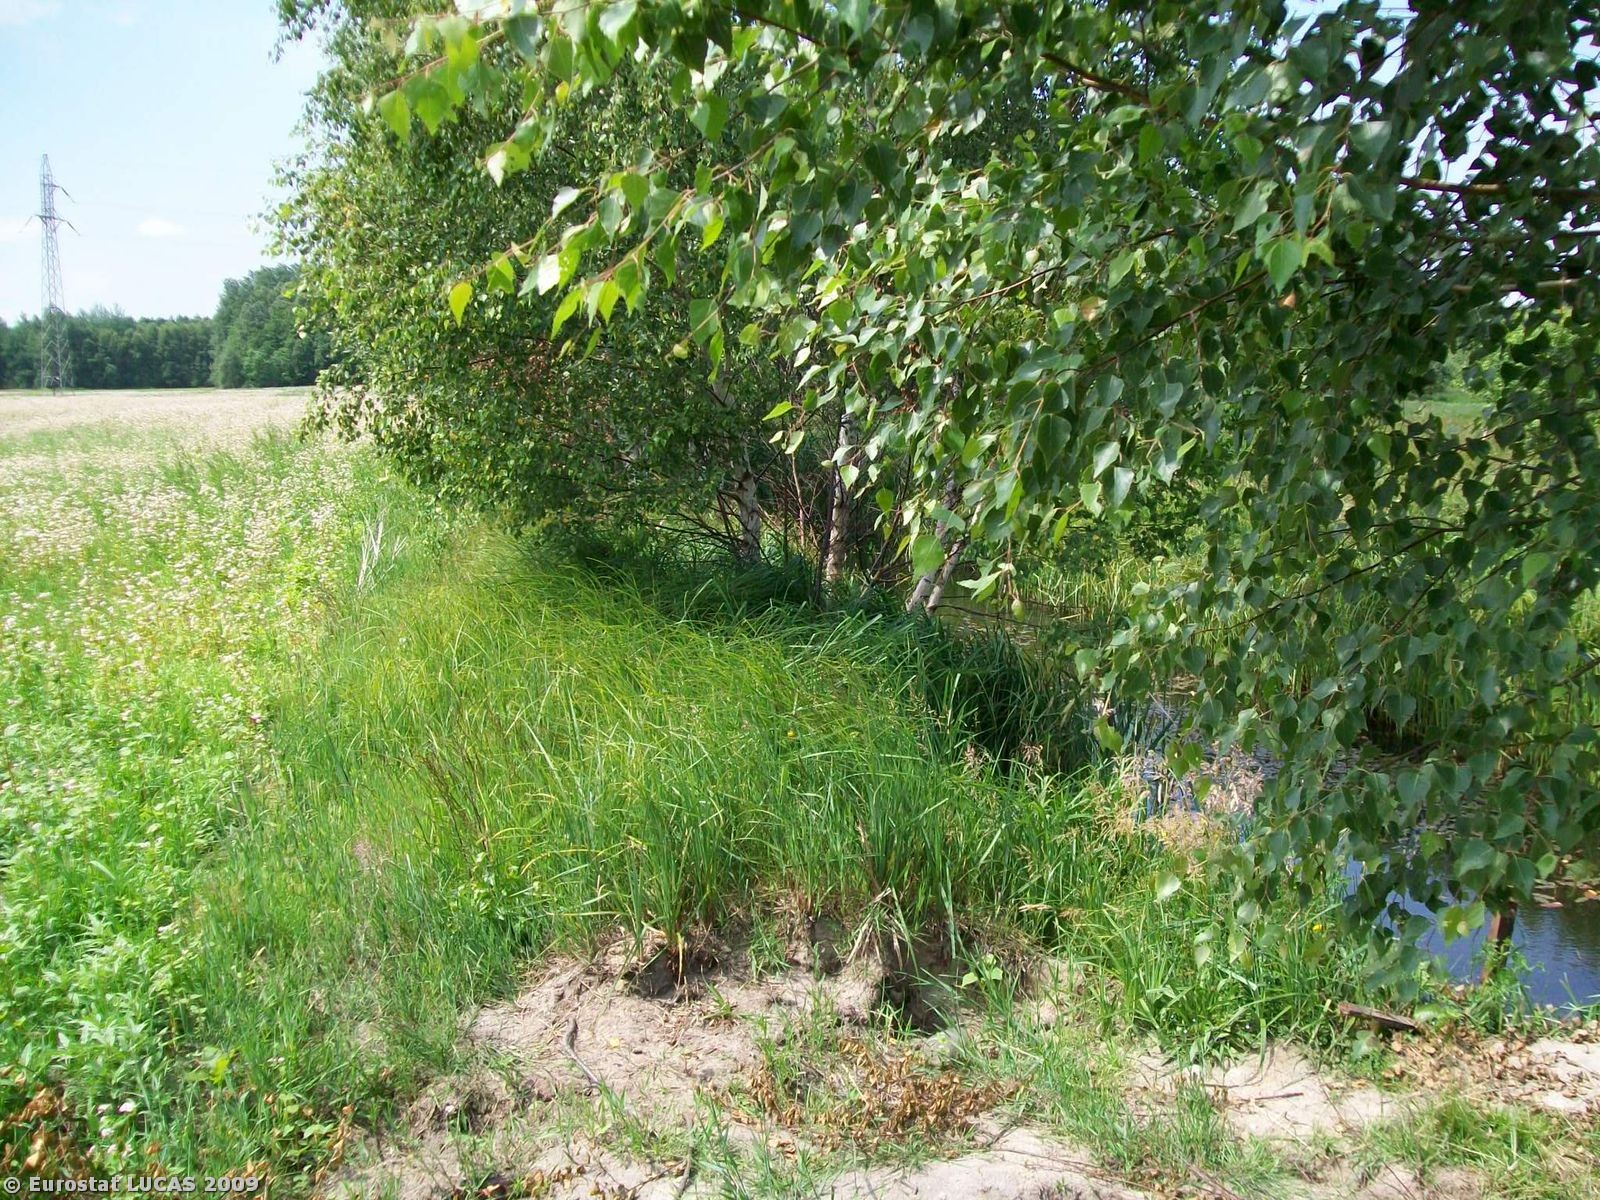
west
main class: Cropland
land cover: Other cereals
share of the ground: > 75 %
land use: Agriculture (excluding fallow land and kitchen gardens)
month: June
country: PL
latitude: 51.5439
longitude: 15.1799
